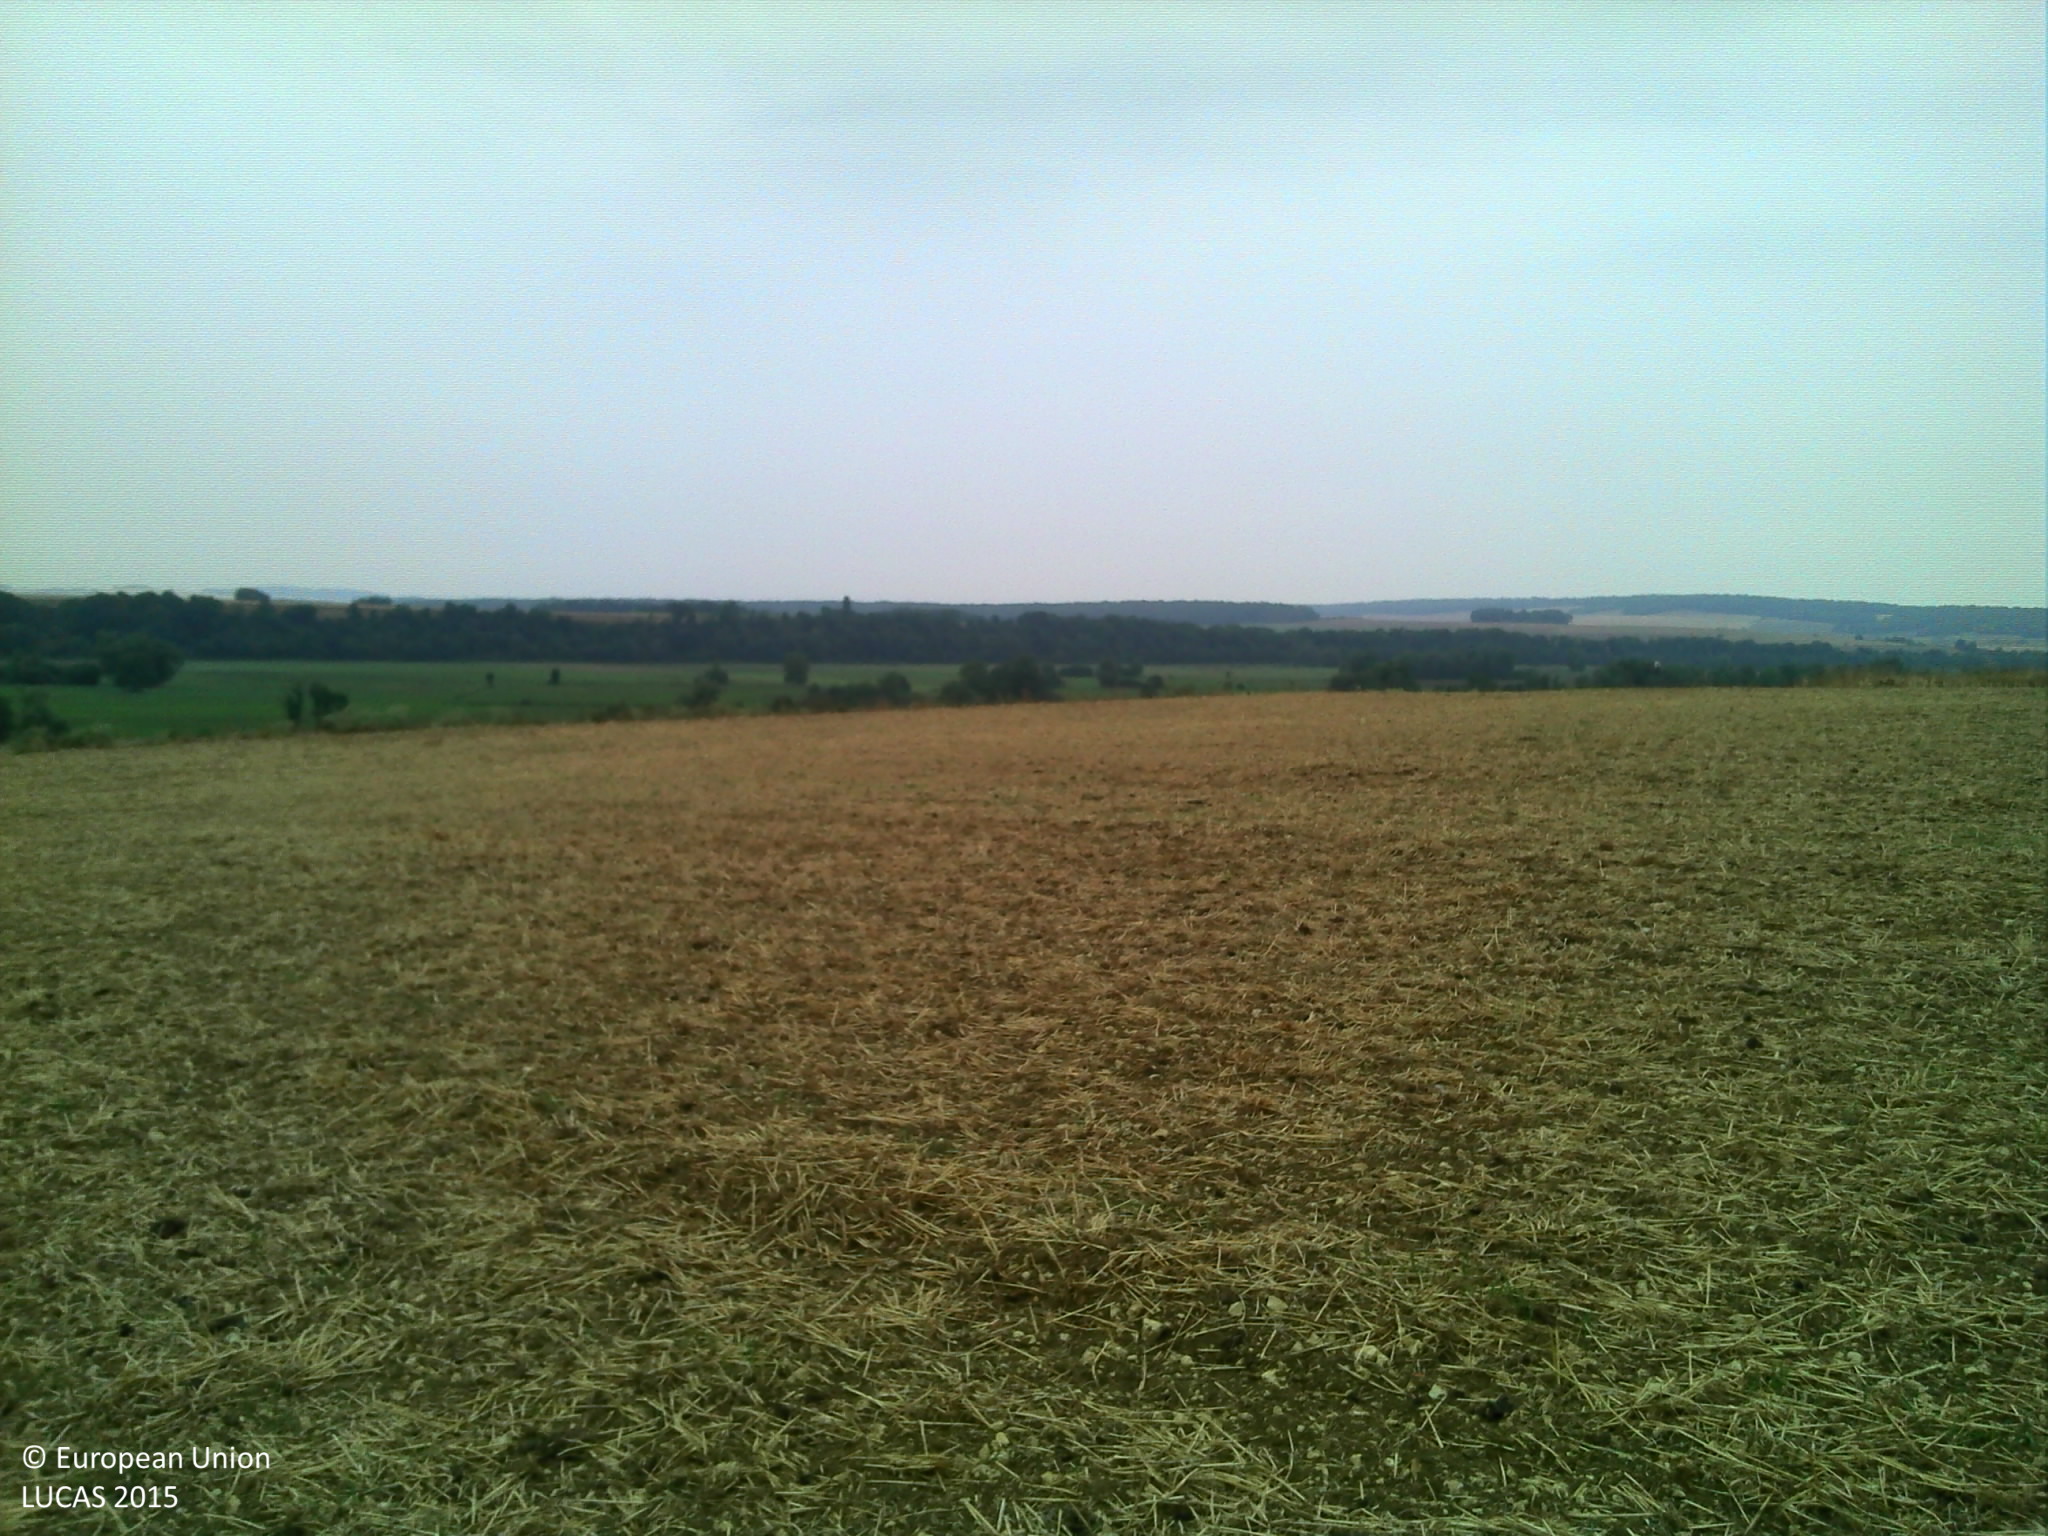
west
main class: Cropland
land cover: Barley
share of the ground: 10 - 25 %
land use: Agriculture (excluding fallow land and kitchen gardens)
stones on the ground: 25 - 50 %
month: August
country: FR
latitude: 49.2940
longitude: 5.2819
